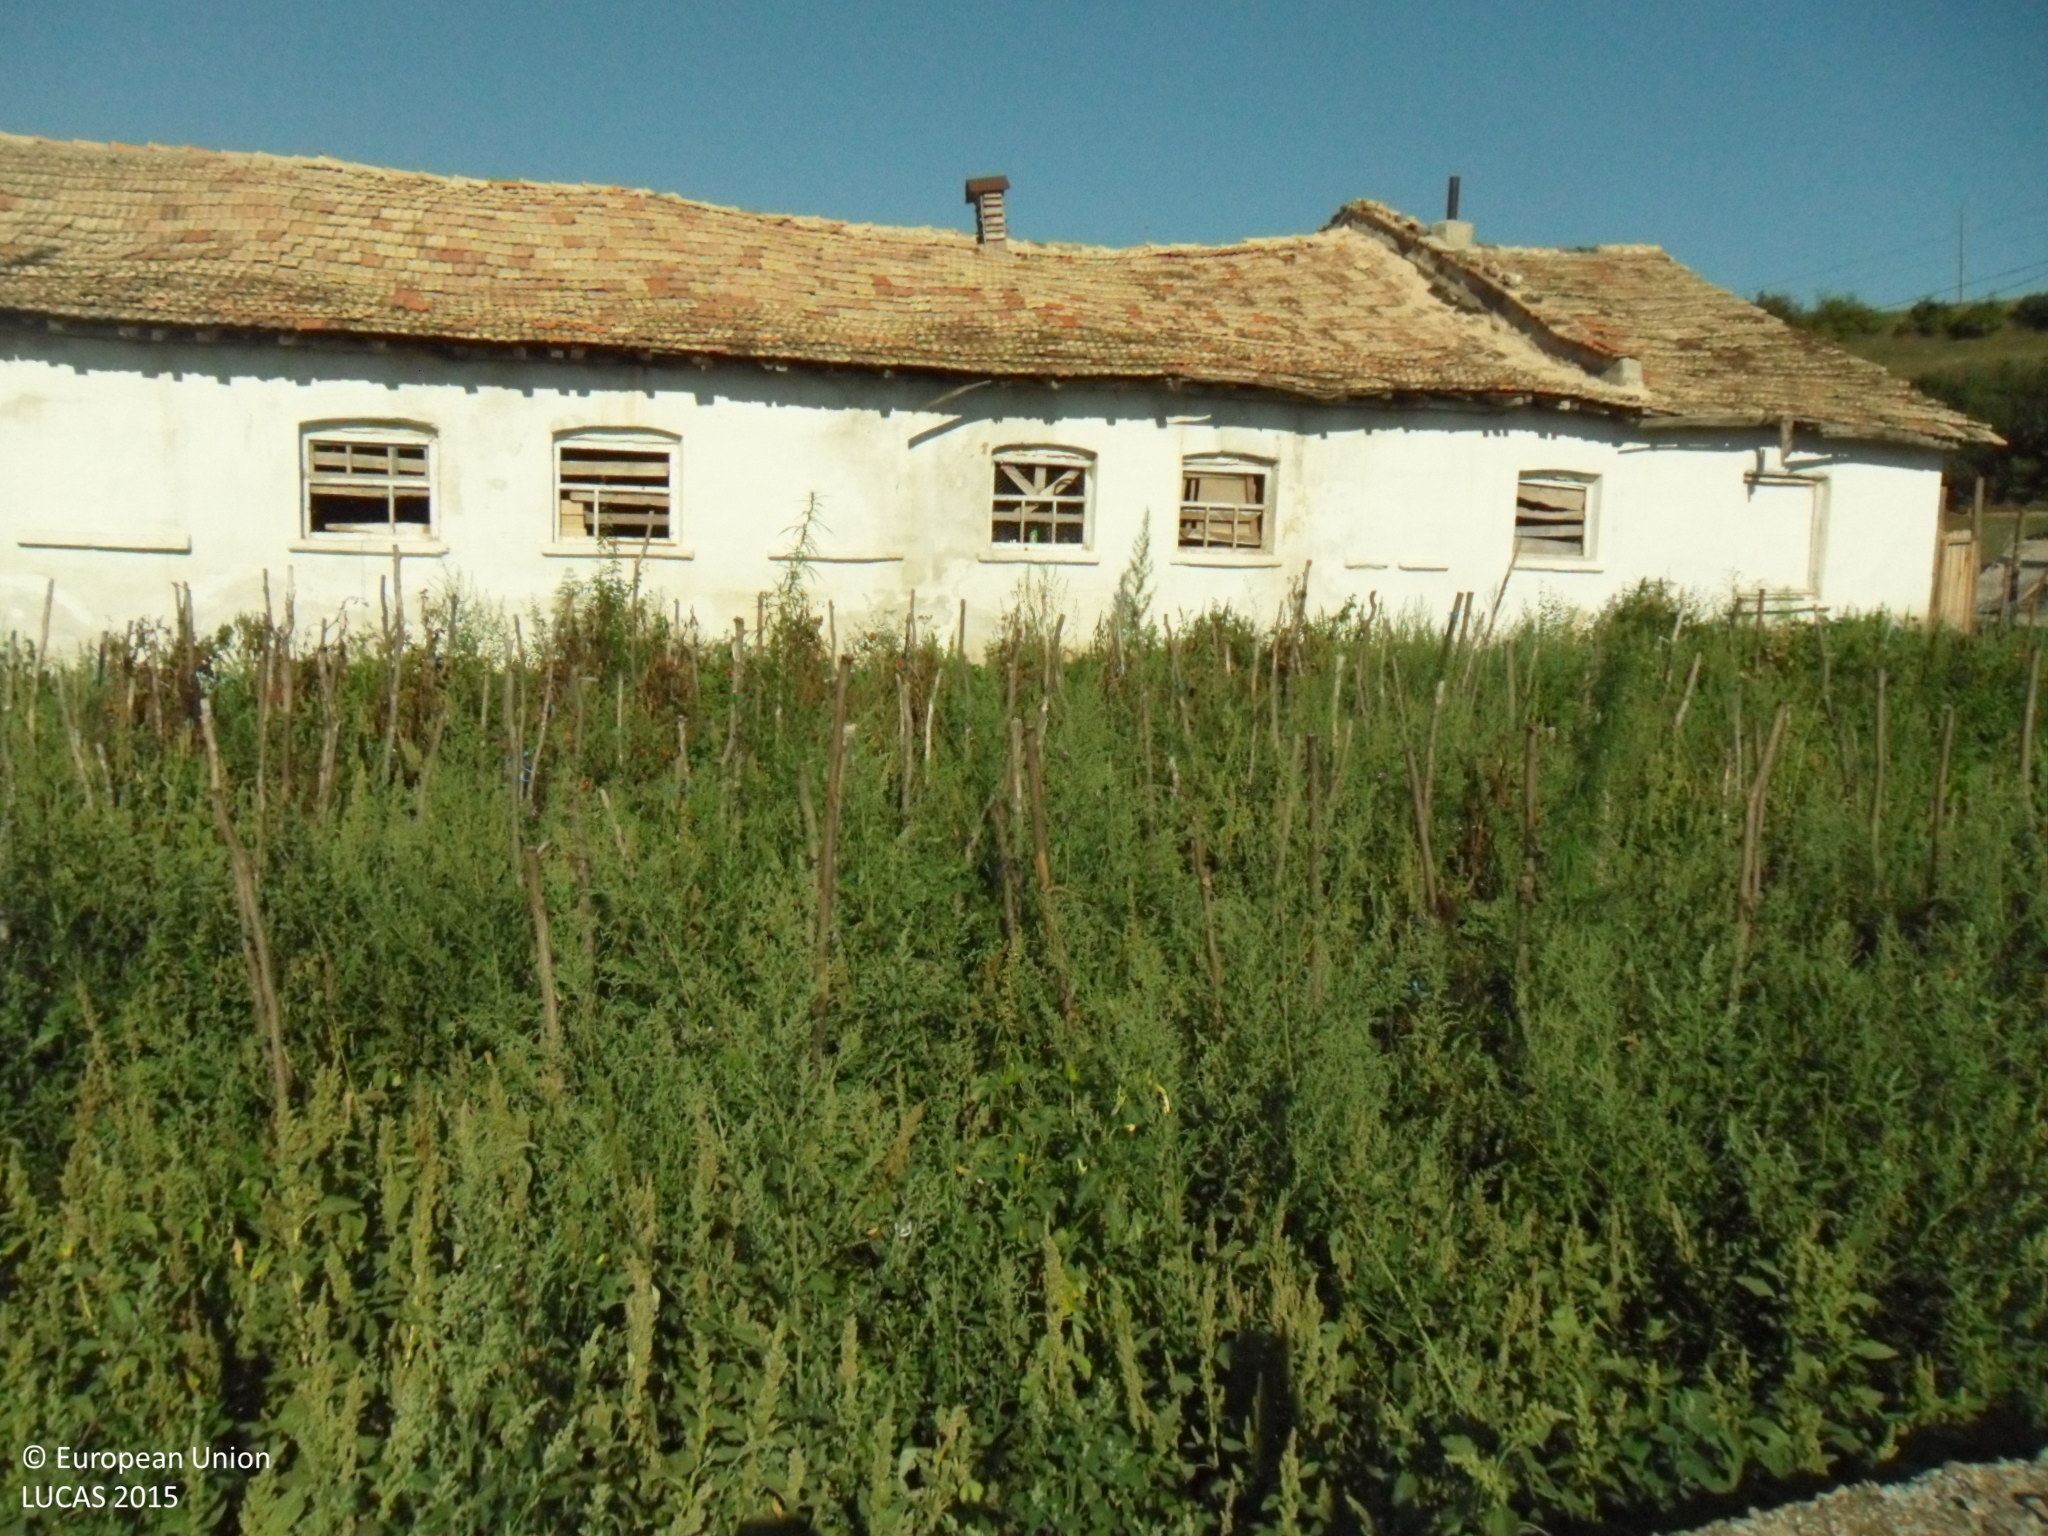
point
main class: Cropland
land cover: Tomatoes
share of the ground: > 75 %
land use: Kitchen garden
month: September
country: BG
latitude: 43.4770
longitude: 27.1699
